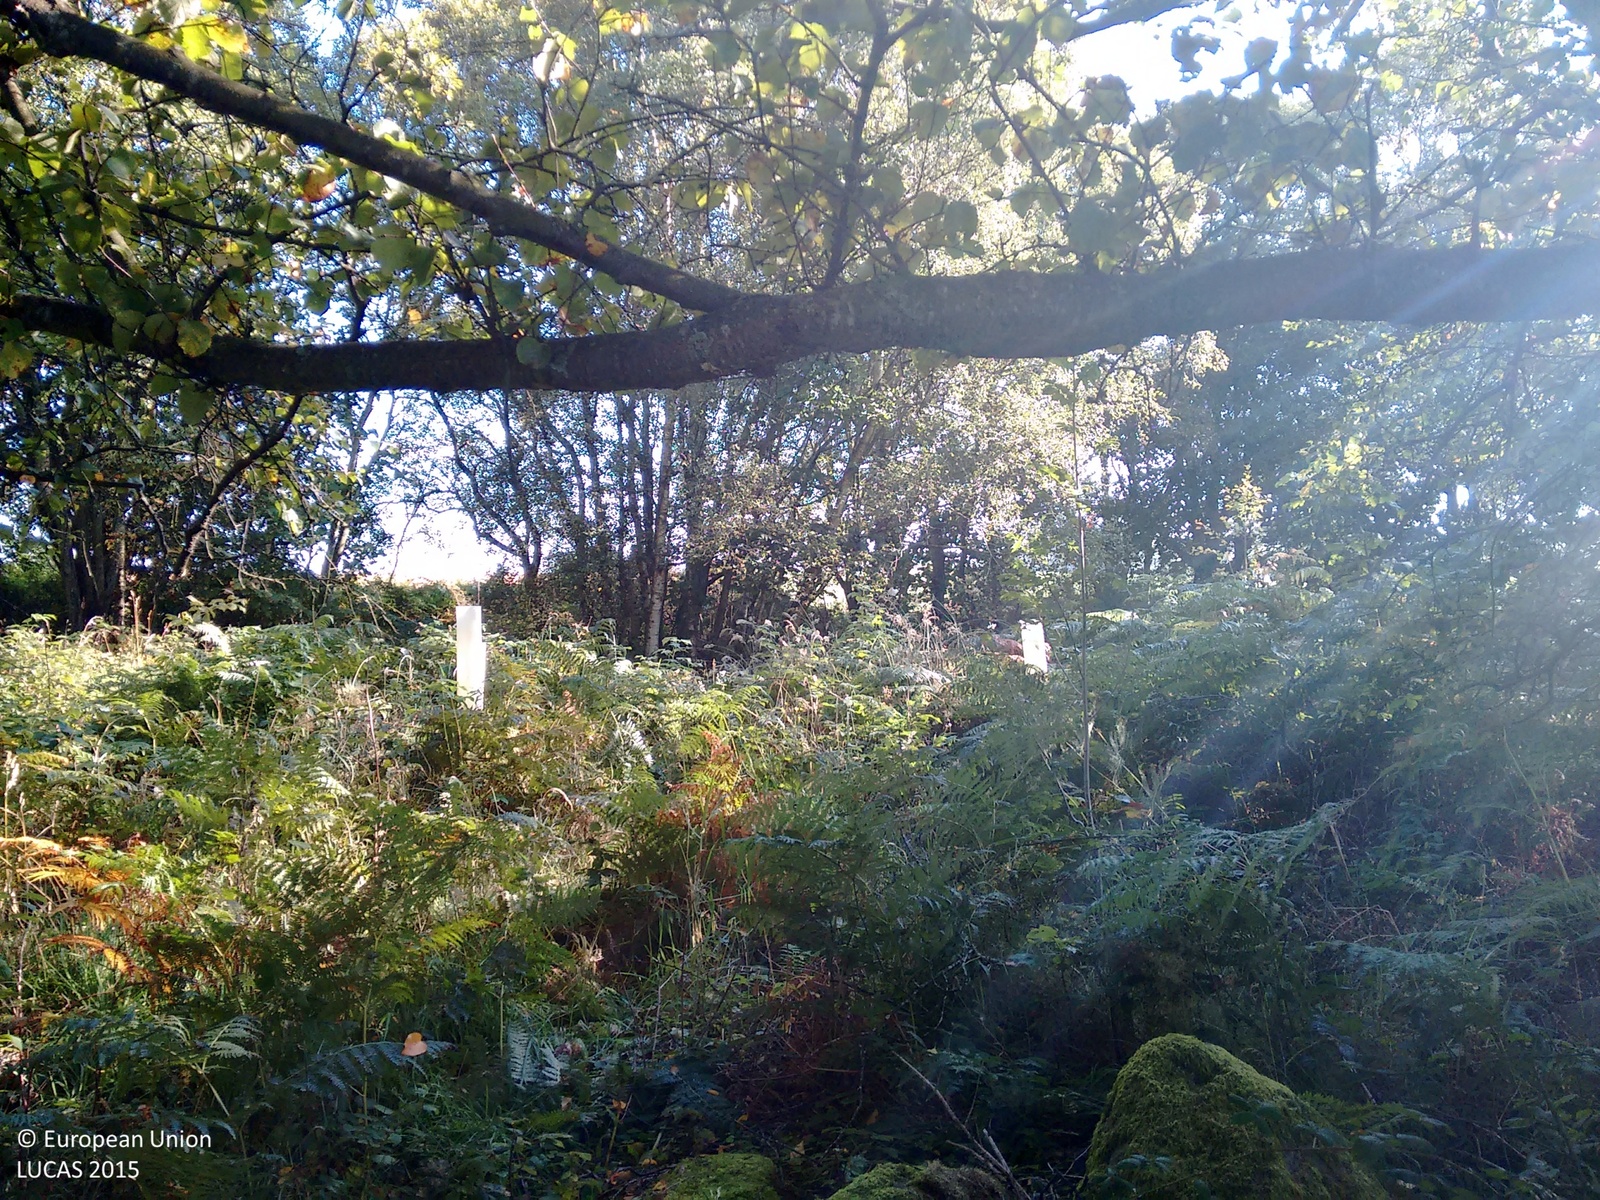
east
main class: Woodland
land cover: Broadleaved woodland
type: floodplain forest
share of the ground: > 75 %
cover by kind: broadleaved forest trees 70 %, herbaceous plants 30 %
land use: Amenities, museums, leisure
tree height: > 5 m
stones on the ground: < 10 %
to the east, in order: Broadleaved woodland; Paved roads, cycling and walking lanes; Grass margins; Dry stone walls; Fences; Grassland without tree/shrub cover; Electric lines; Grassland without tree/shrub cover
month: September
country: GB
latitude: 56.5799
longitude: -3.5387
